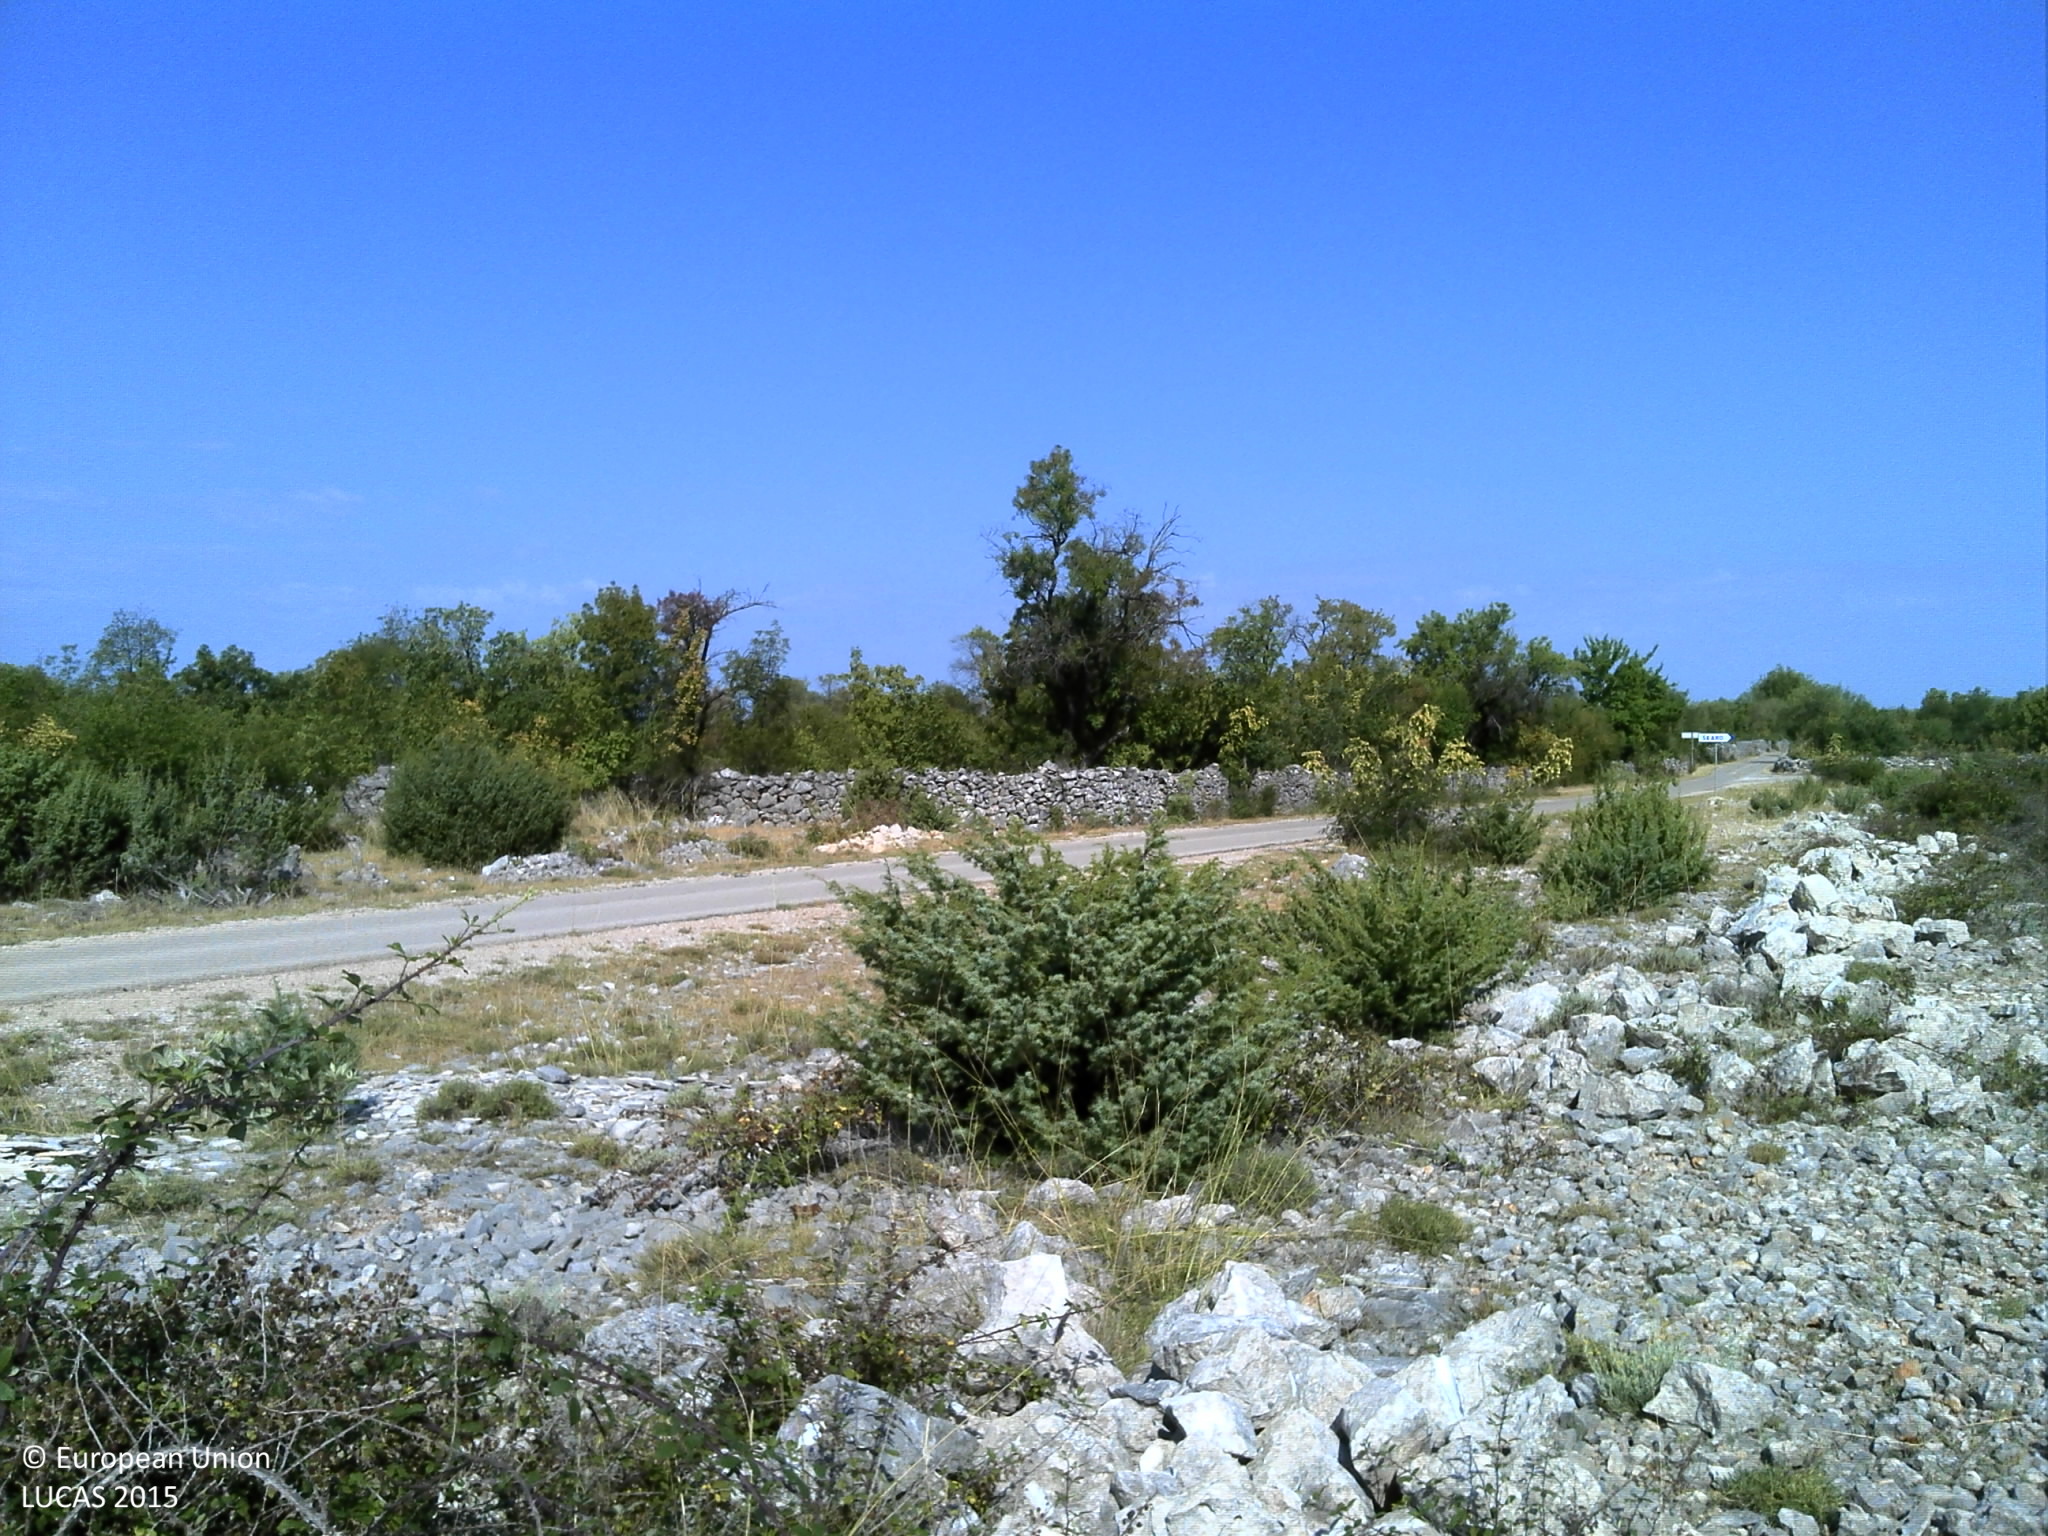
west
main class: Shrubland
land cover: Shrubland without tree cover
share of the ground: 25 - 50 %
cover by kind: unconsolidated bare surface 45 %, shrubs 30 %, herbaceous plants 15 %, consolidated bare surface 10 %
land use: Semi-natural and natural areas not in use
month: July
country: HR
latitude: 43.7737
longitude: 16.0914
